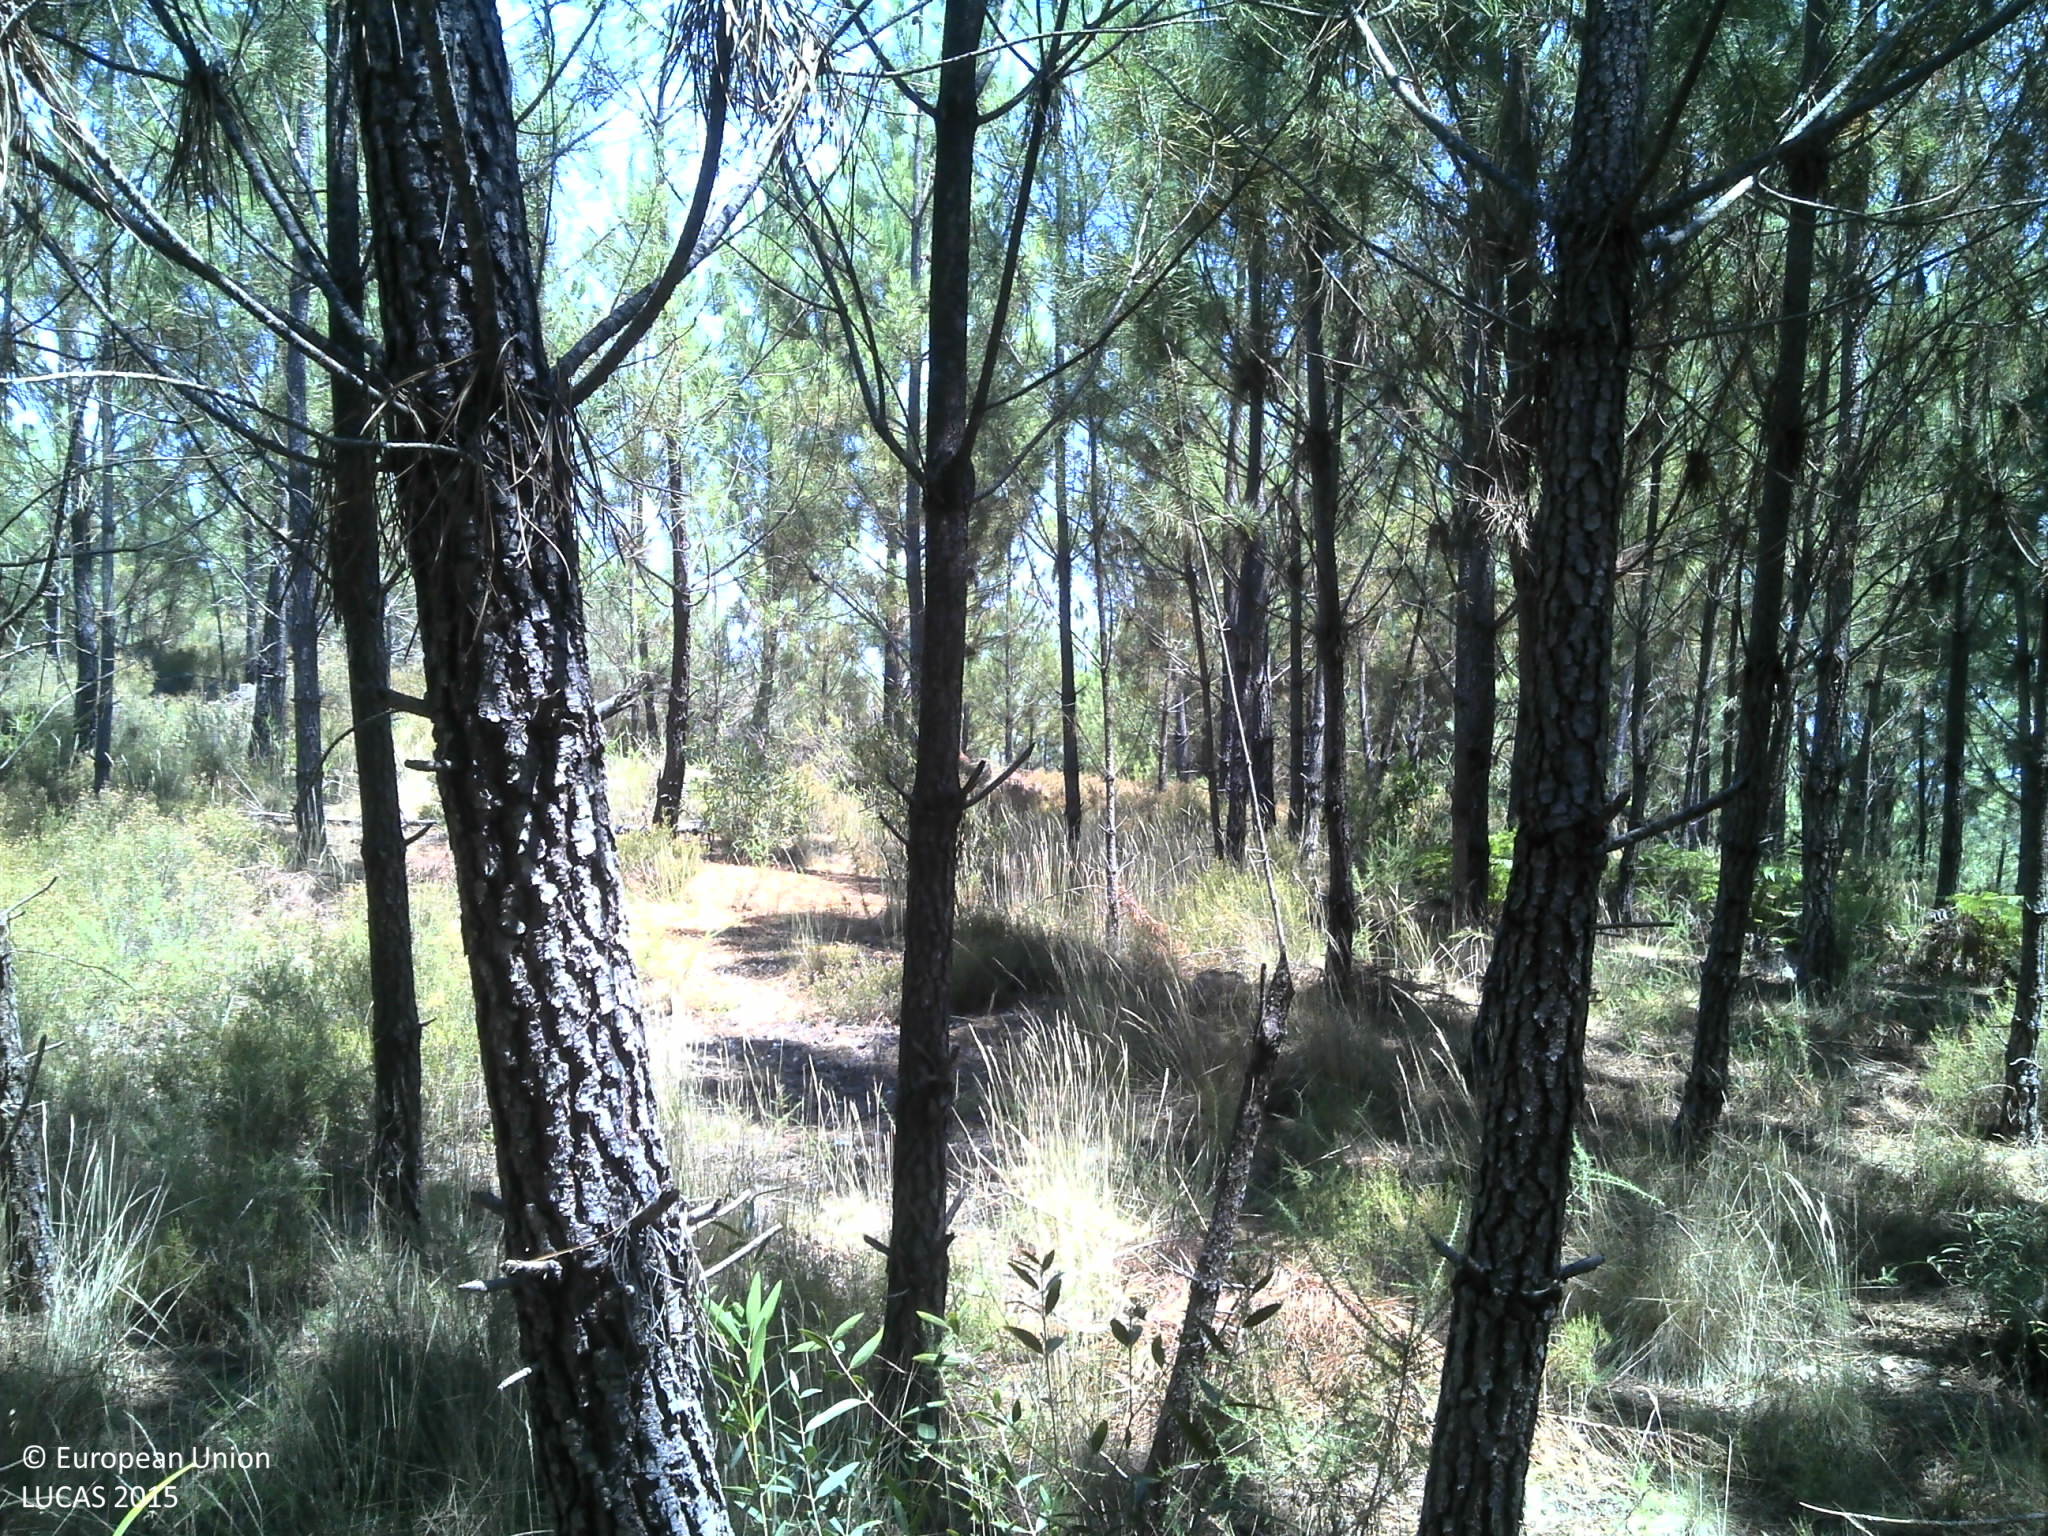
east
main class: Woodland
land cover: Pine dominated coniferous woodland
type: coniferous forest of the mediterranean region
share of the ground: 50 - 75 %
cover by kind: coniferous forest trees 75 %, unconsolidated bare surface 15 %, shrubs 10 %
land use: Forestry
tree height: > 5 m
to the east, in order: Pine dominated coniferous woodland; Rocks and stones; Pine dominated coniferous woodland; Shrubland with sparse tree cover; Rocks and stones; Shrubland without tree cover; Rocks and stones; Pine dominated coniferous woodland; Shrubland without tree cover; Pine dominated coniferous woodland
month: June
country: PT
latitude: 40.5080
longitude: -8.0030
